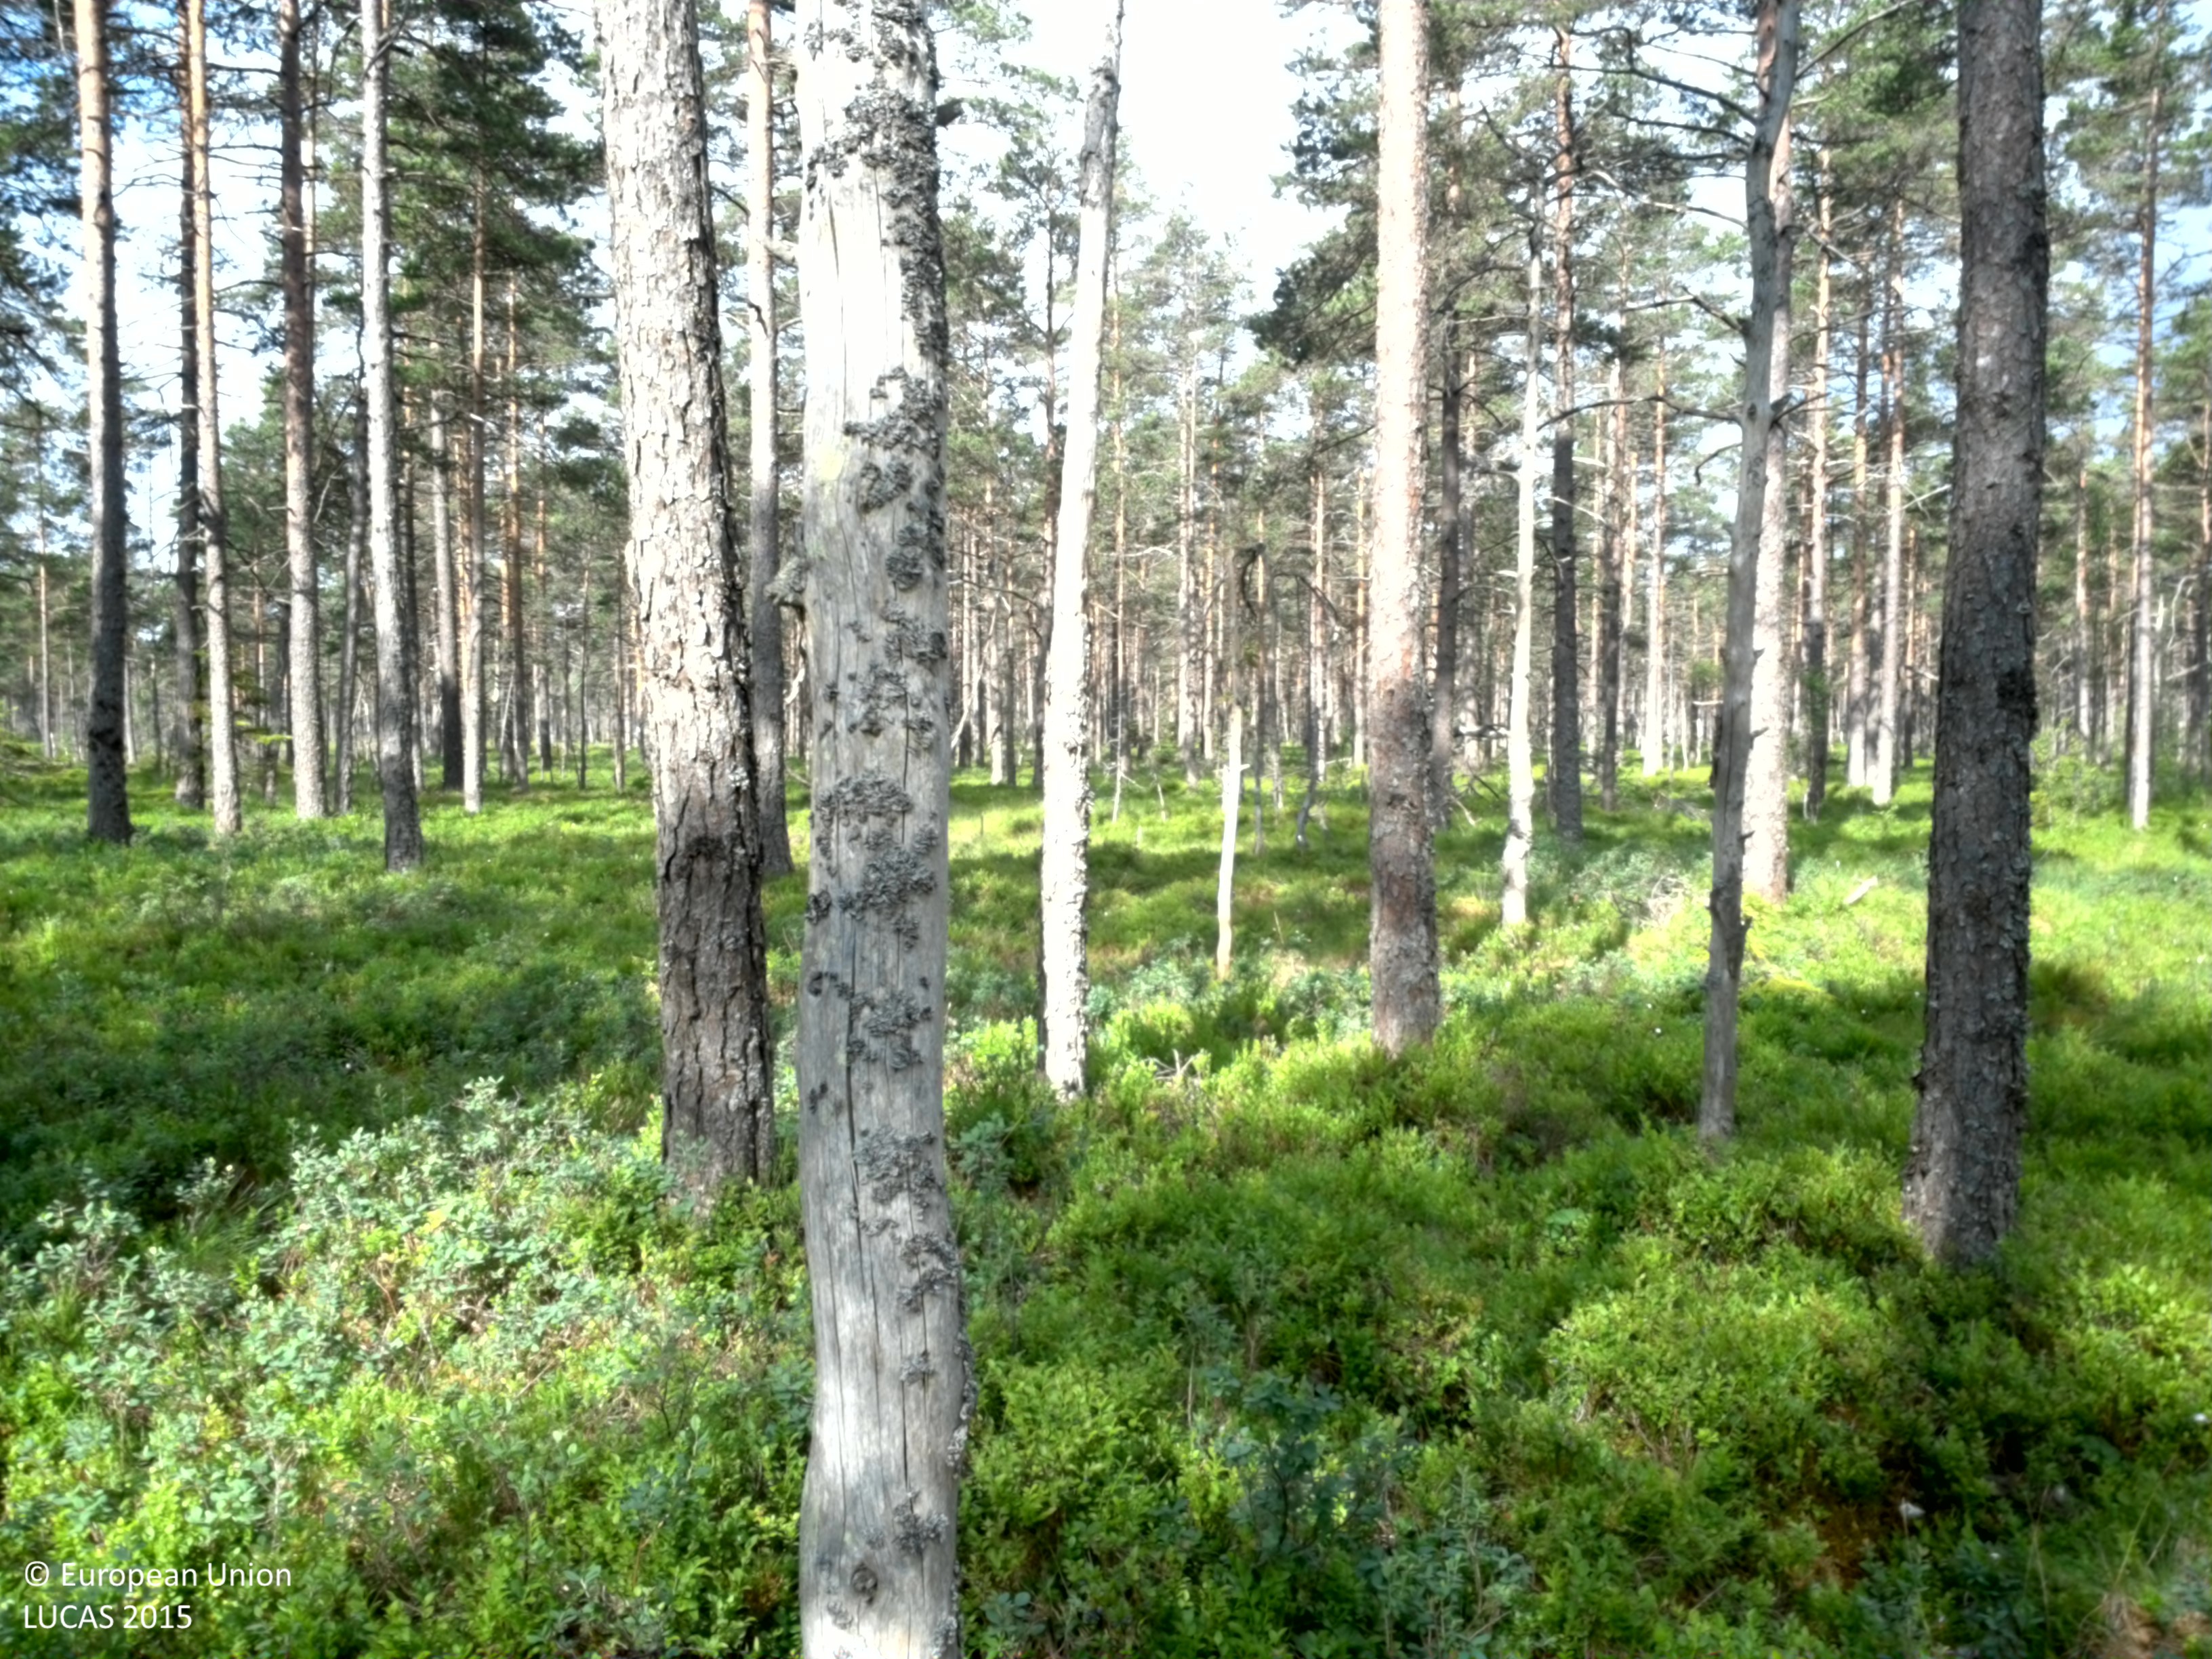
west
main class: Woodland
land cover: Pine dominated coniferous woodland
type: boreal forest
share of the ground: 50 - 75 %
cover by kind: coniferous forest trees 70 %, shrubs 15 %, lichens and mosses 15 %
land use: Forestry
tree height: > 5 m
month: July
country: SE
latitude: 57.5657
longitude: 14.5594
